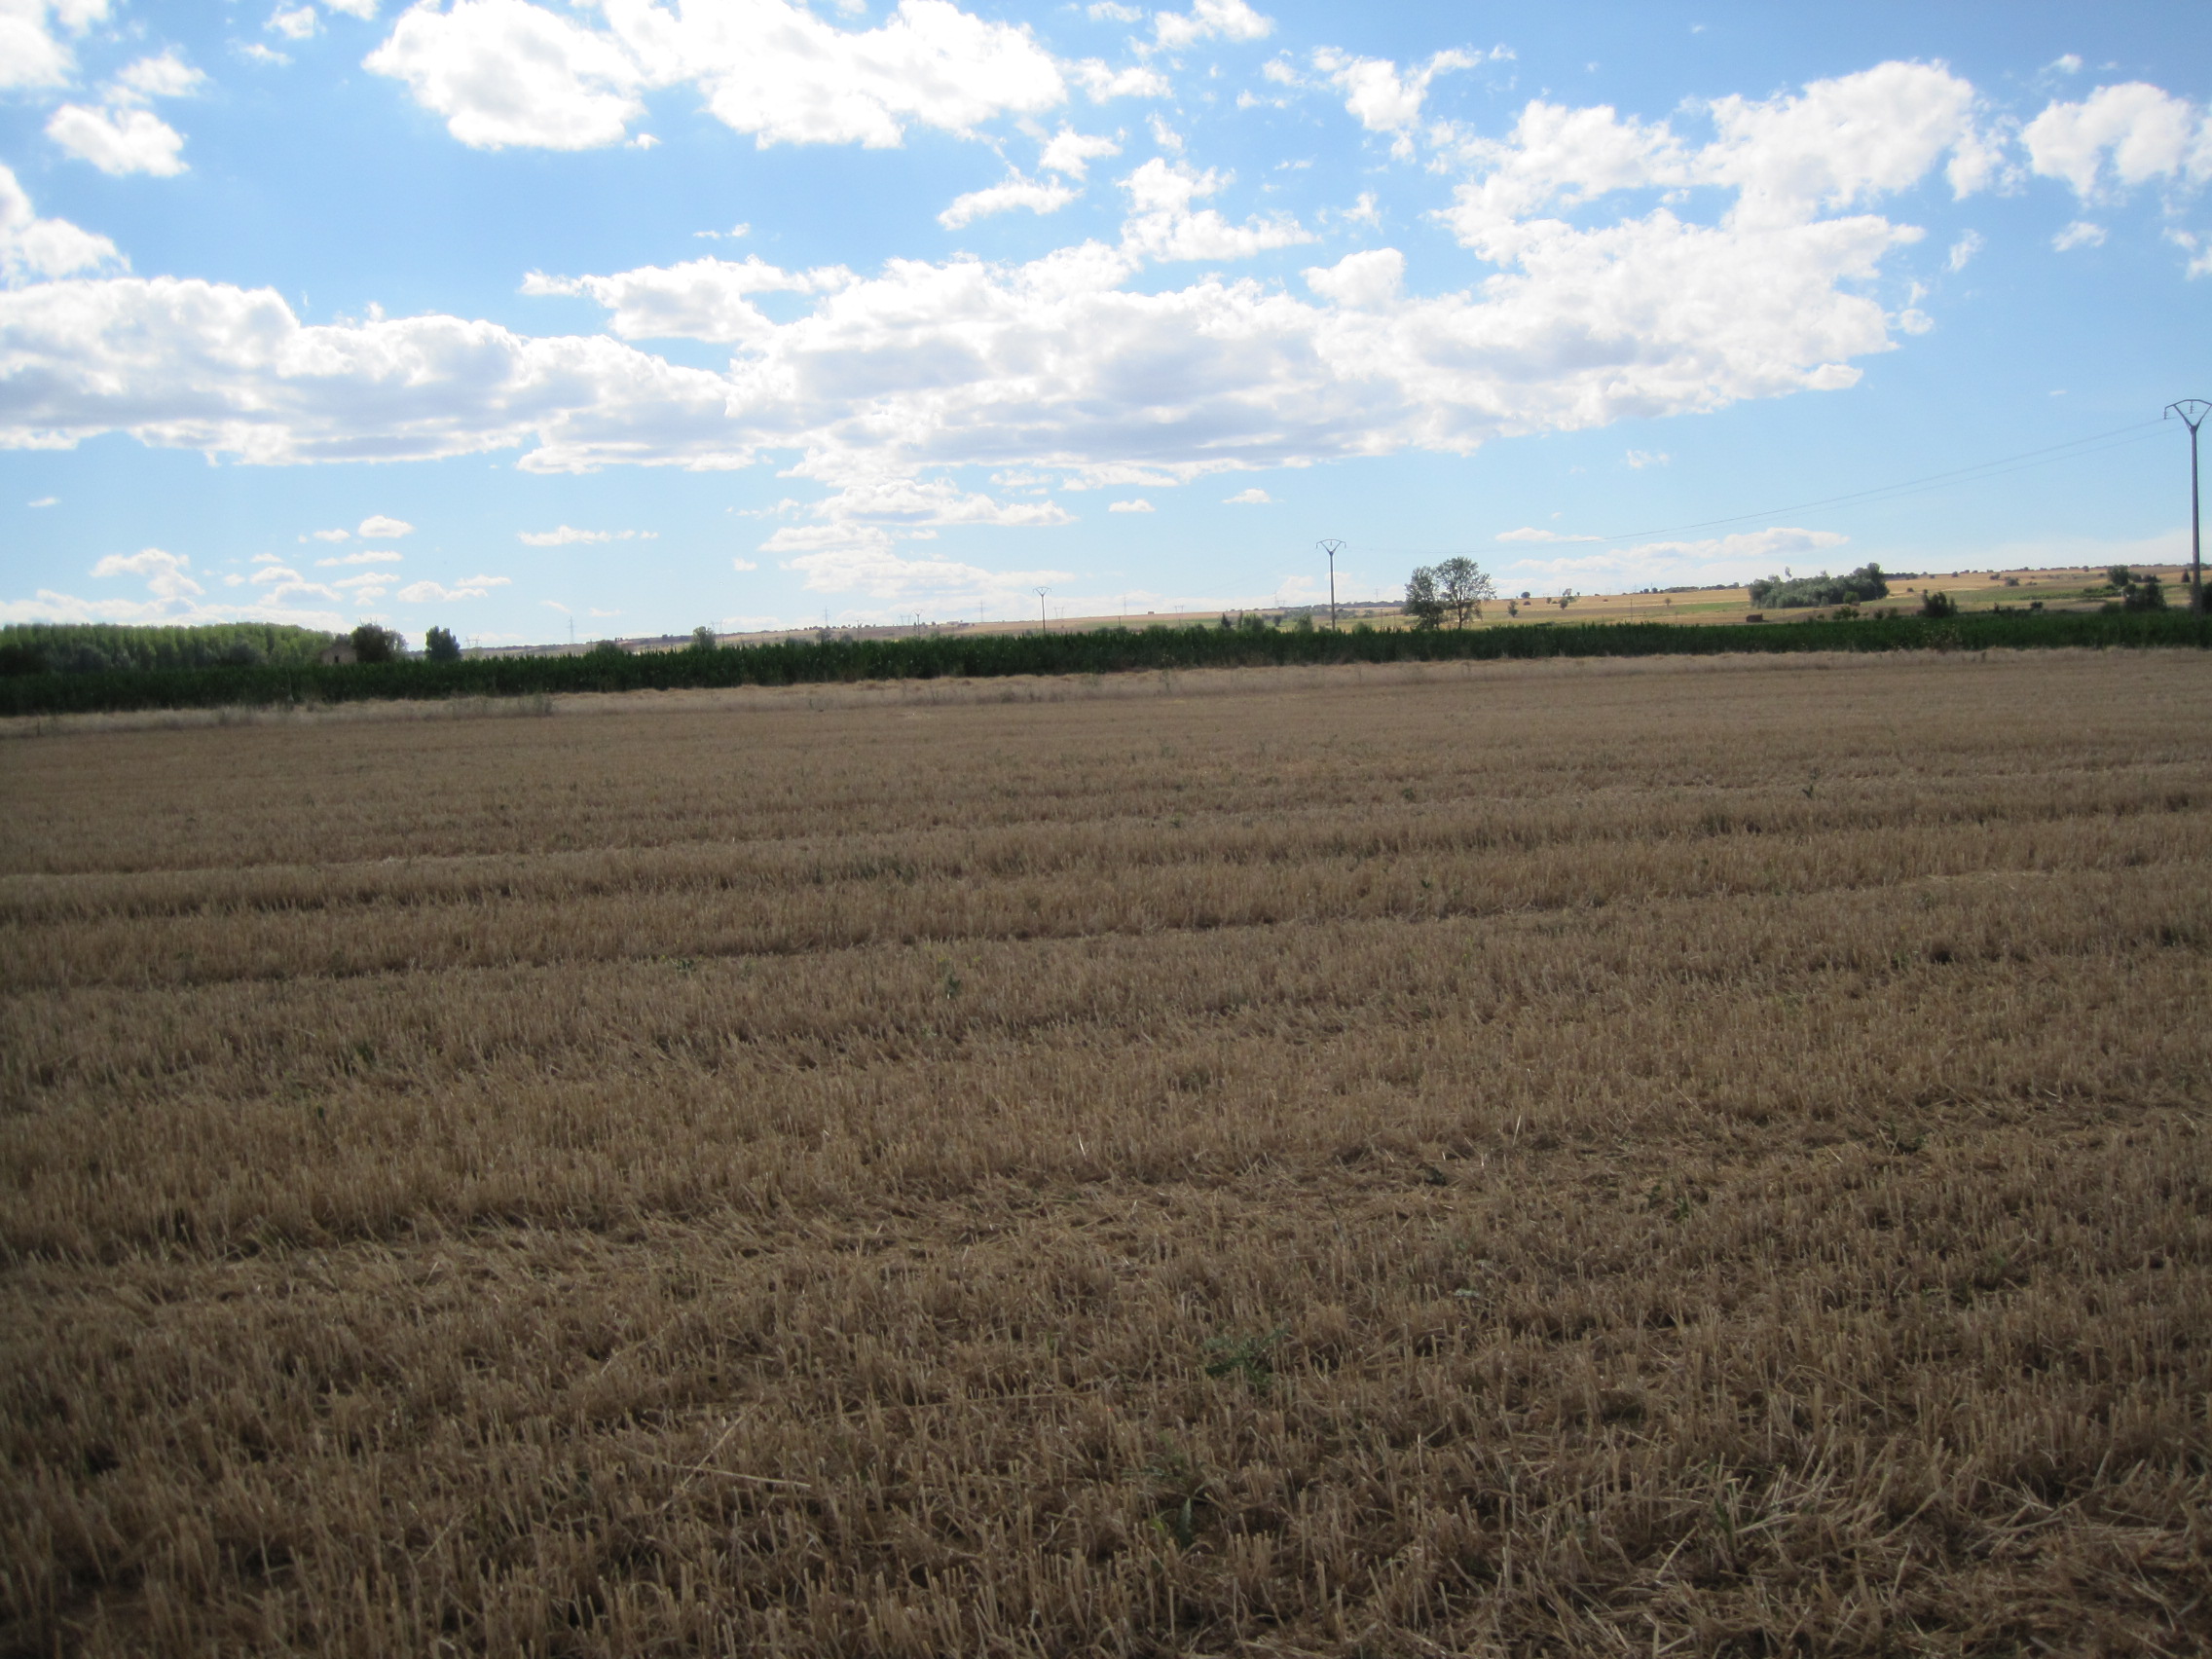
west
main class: Cropland
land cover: Common wheat
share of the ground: < 10 %
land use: Agriculture (excluding fallow land and kitchen gardens)
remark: Harvested field
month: July
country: ES
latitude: 42.0838
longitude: -5.4530
